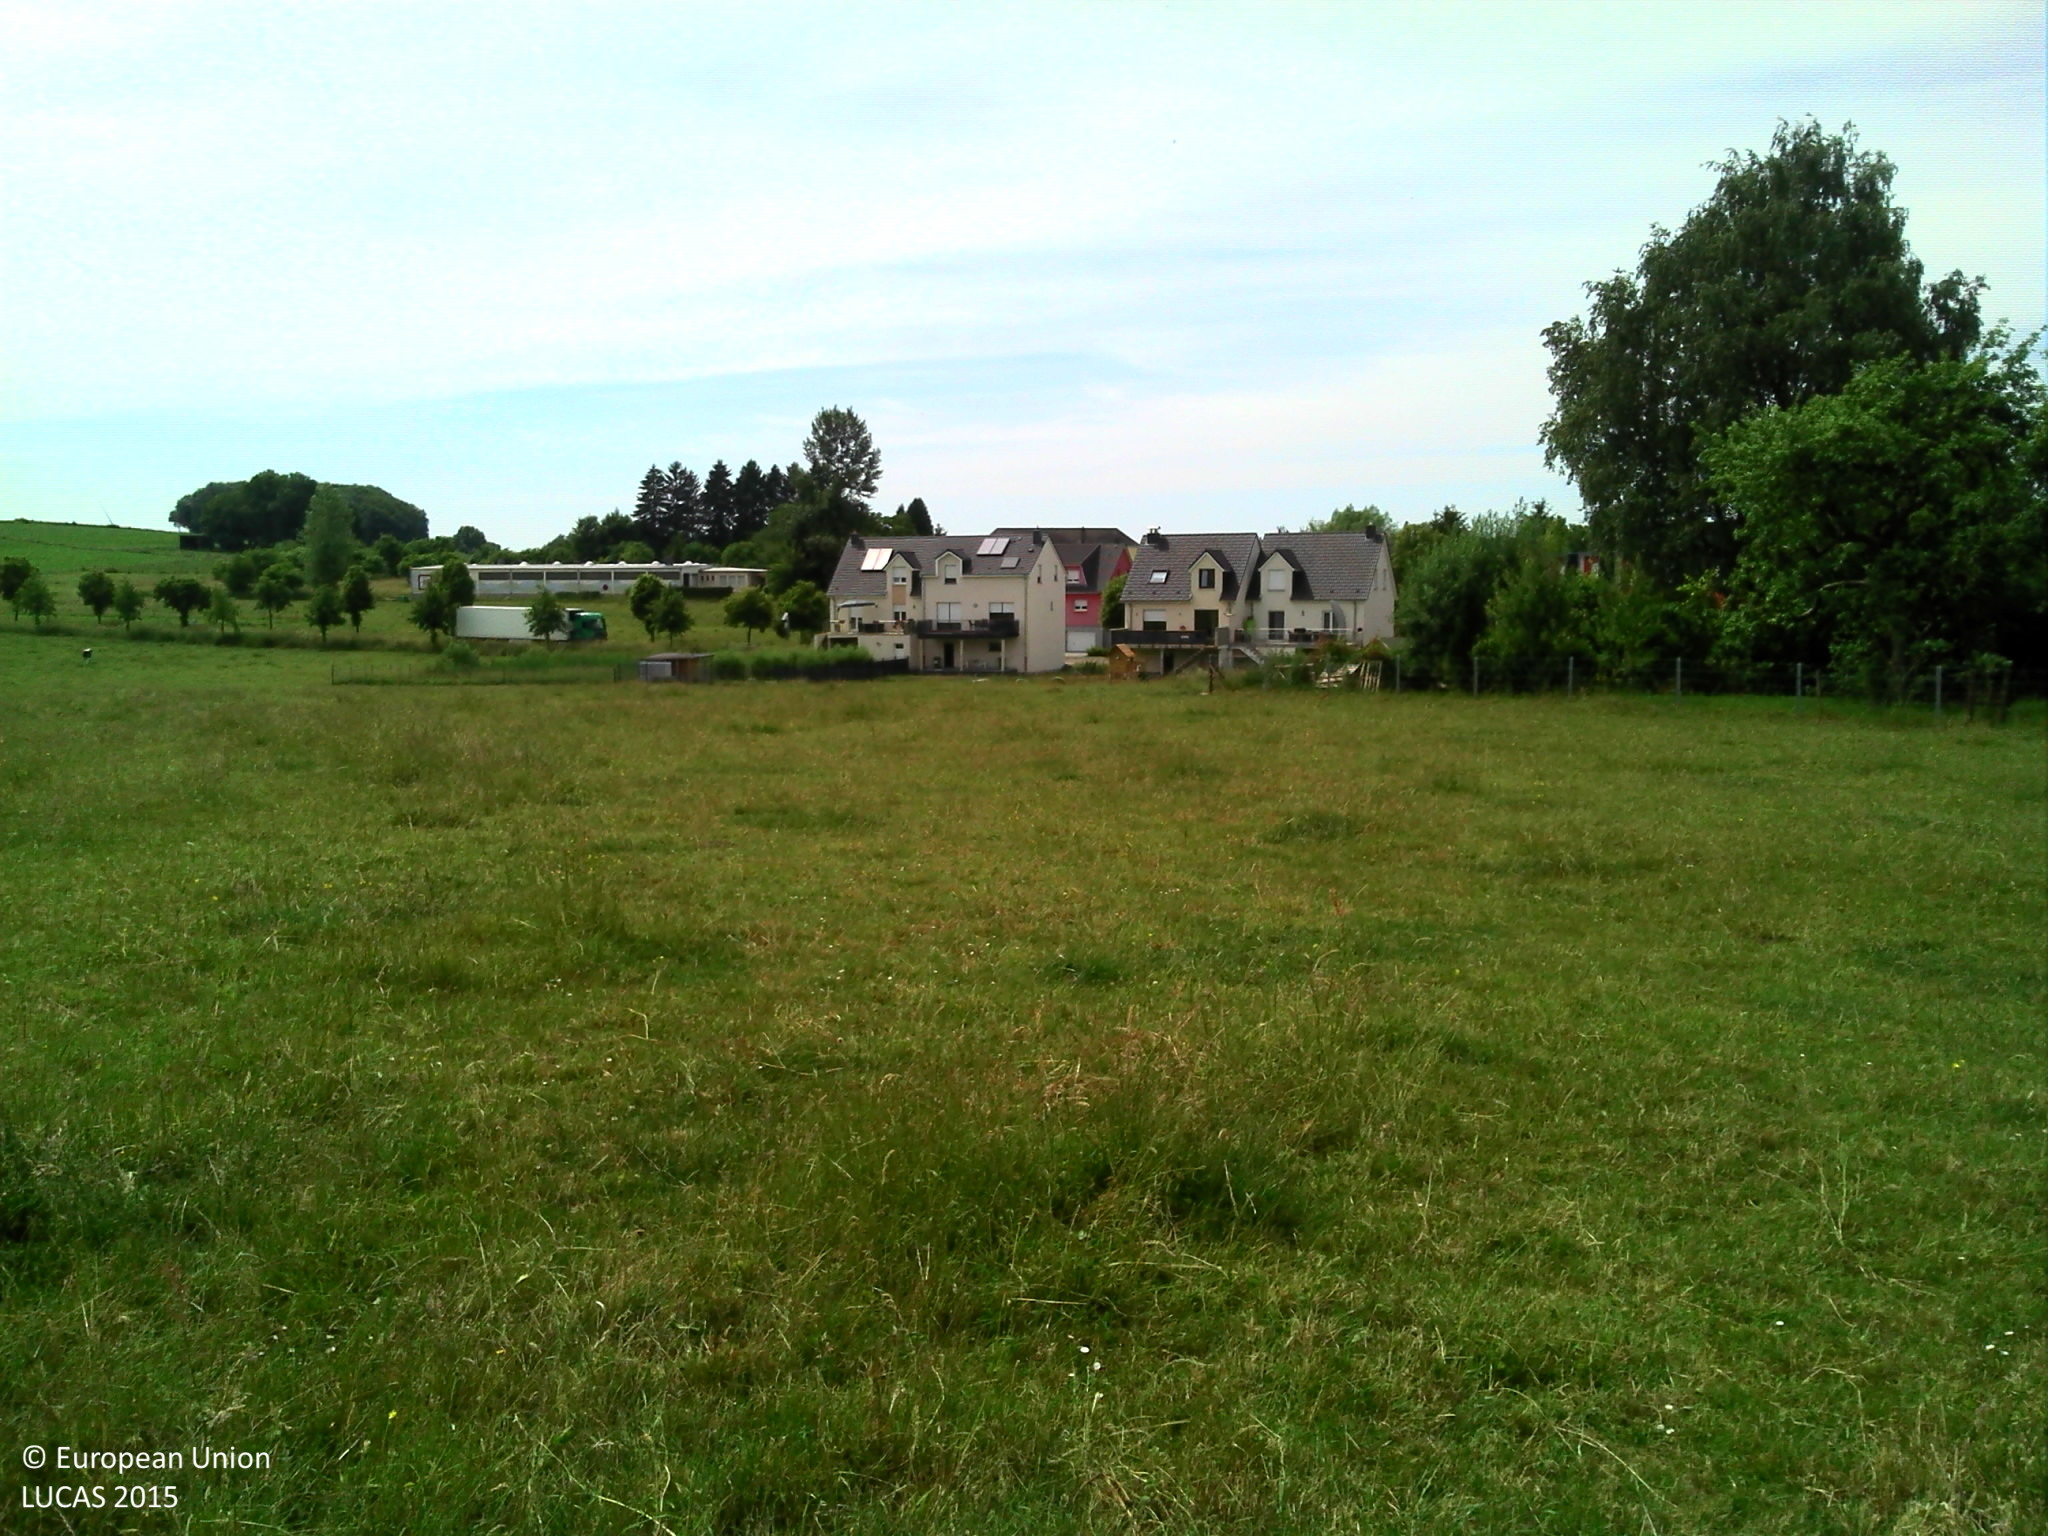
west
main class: Grassland
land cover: Grassland without tree/shrub cover
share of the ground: > 75 %
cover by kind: herbaceous plants 100 %
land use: Agriculture (excluding fallow land and kitchen gardens)
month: June
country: LU
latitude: 49.6429
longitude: 5.9138
